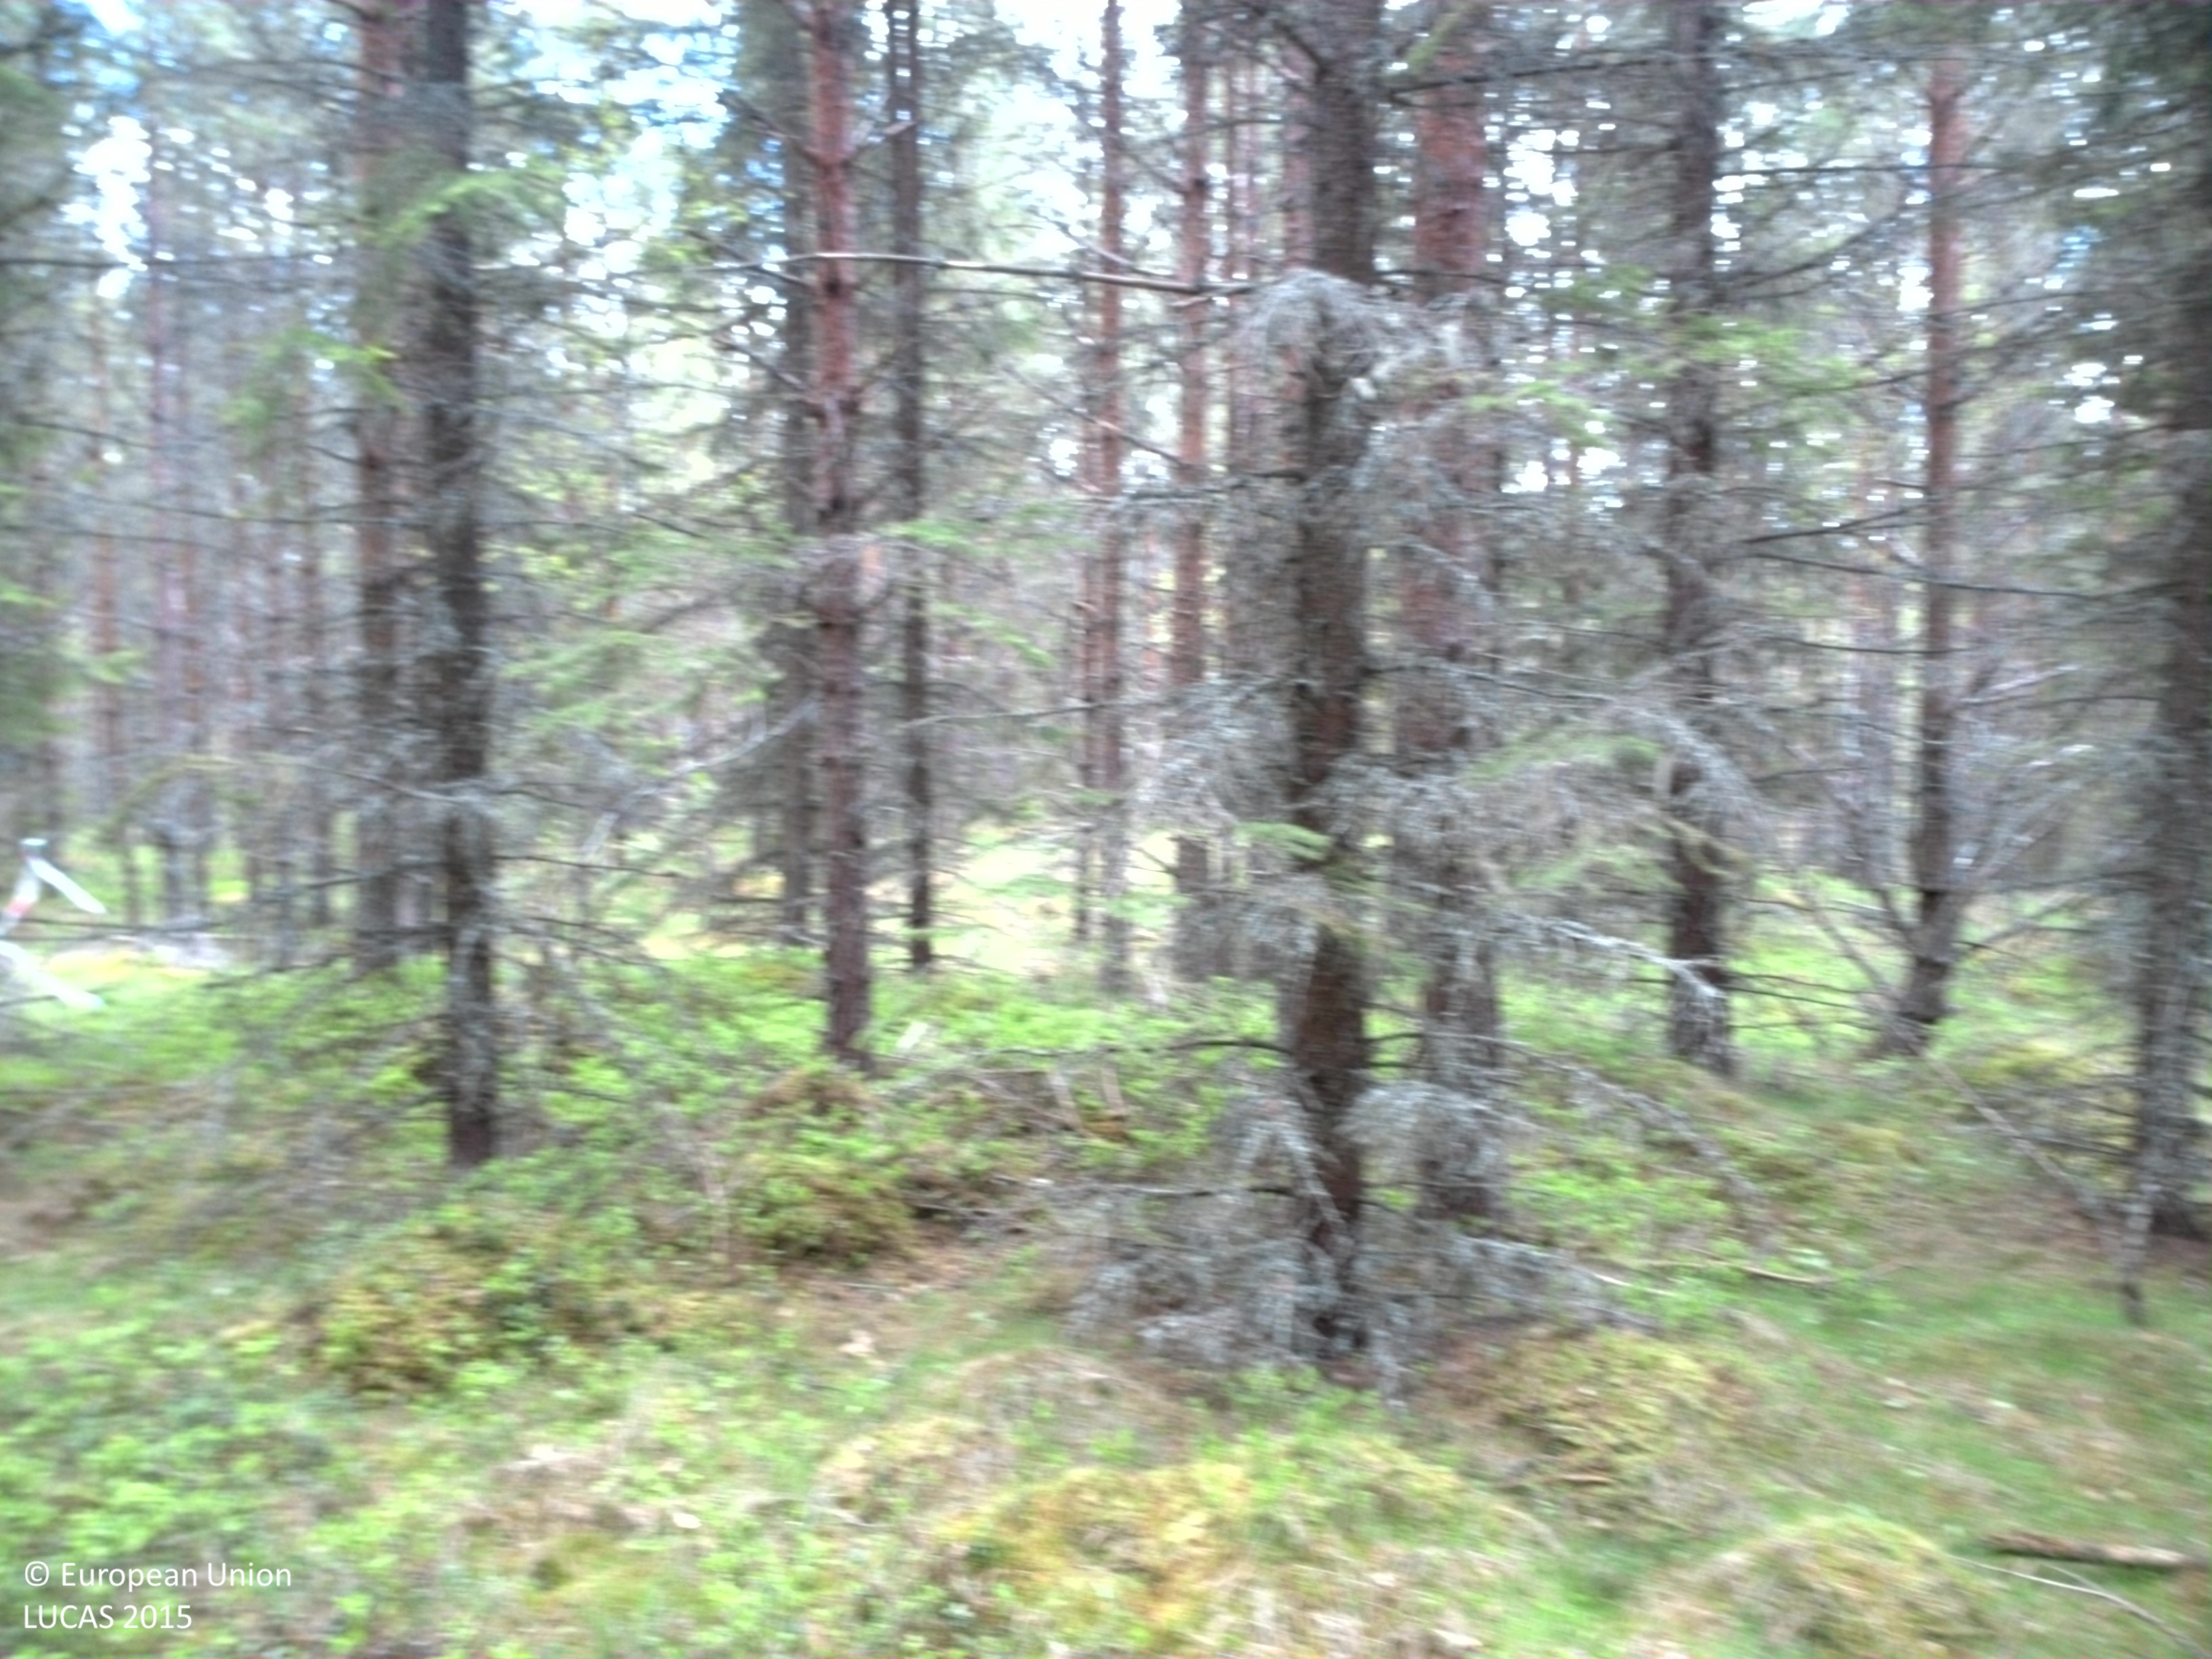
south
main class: Woodland
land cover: Pine dominated coniferous woodland
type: boreal forest
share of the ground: 50 - 75 %
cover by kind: coniferous forest trees 65 %, herbaceous plants 30 %, lichens and mosses 5 %
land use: Forestry
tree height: > 5 m
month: May
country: SE
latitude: 61.2822
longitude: 15.5258
